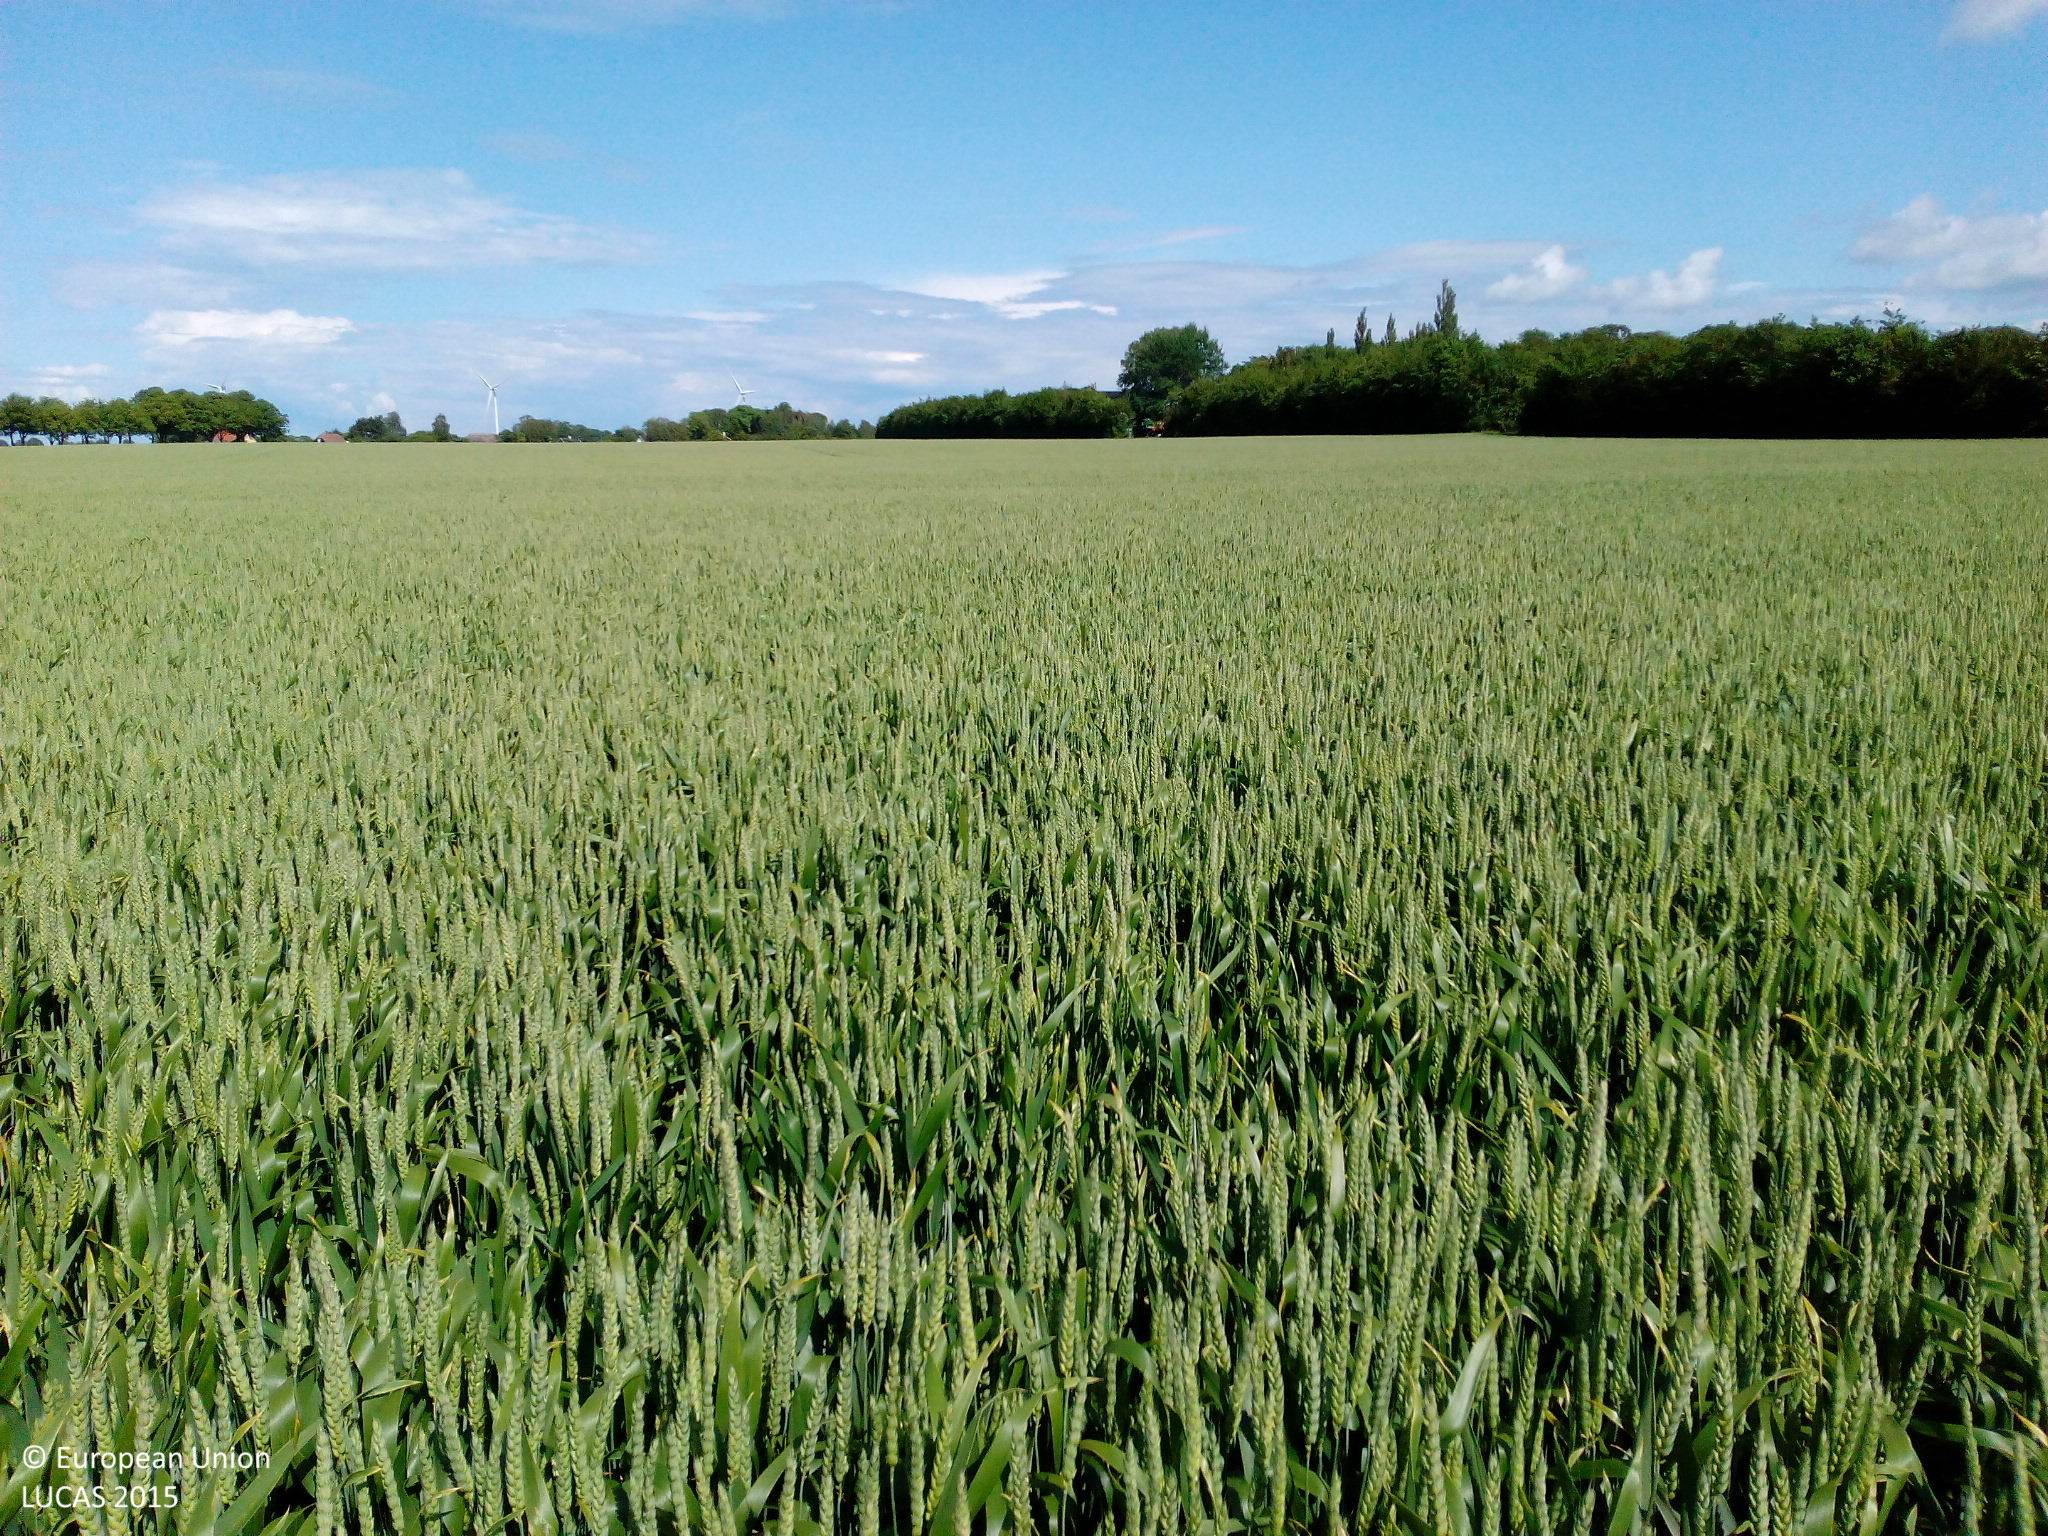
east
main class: Cropland
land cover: Common wheat
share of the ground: > 75 %
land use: Agriculture (excluding fallow land and kitchen gardens)
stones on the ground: < 10 %
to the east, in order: Common wheat; Broadleaved woodland; Artificial constructions in urban areas
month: June
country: DK
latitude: 54.9244
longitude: 11.1382
